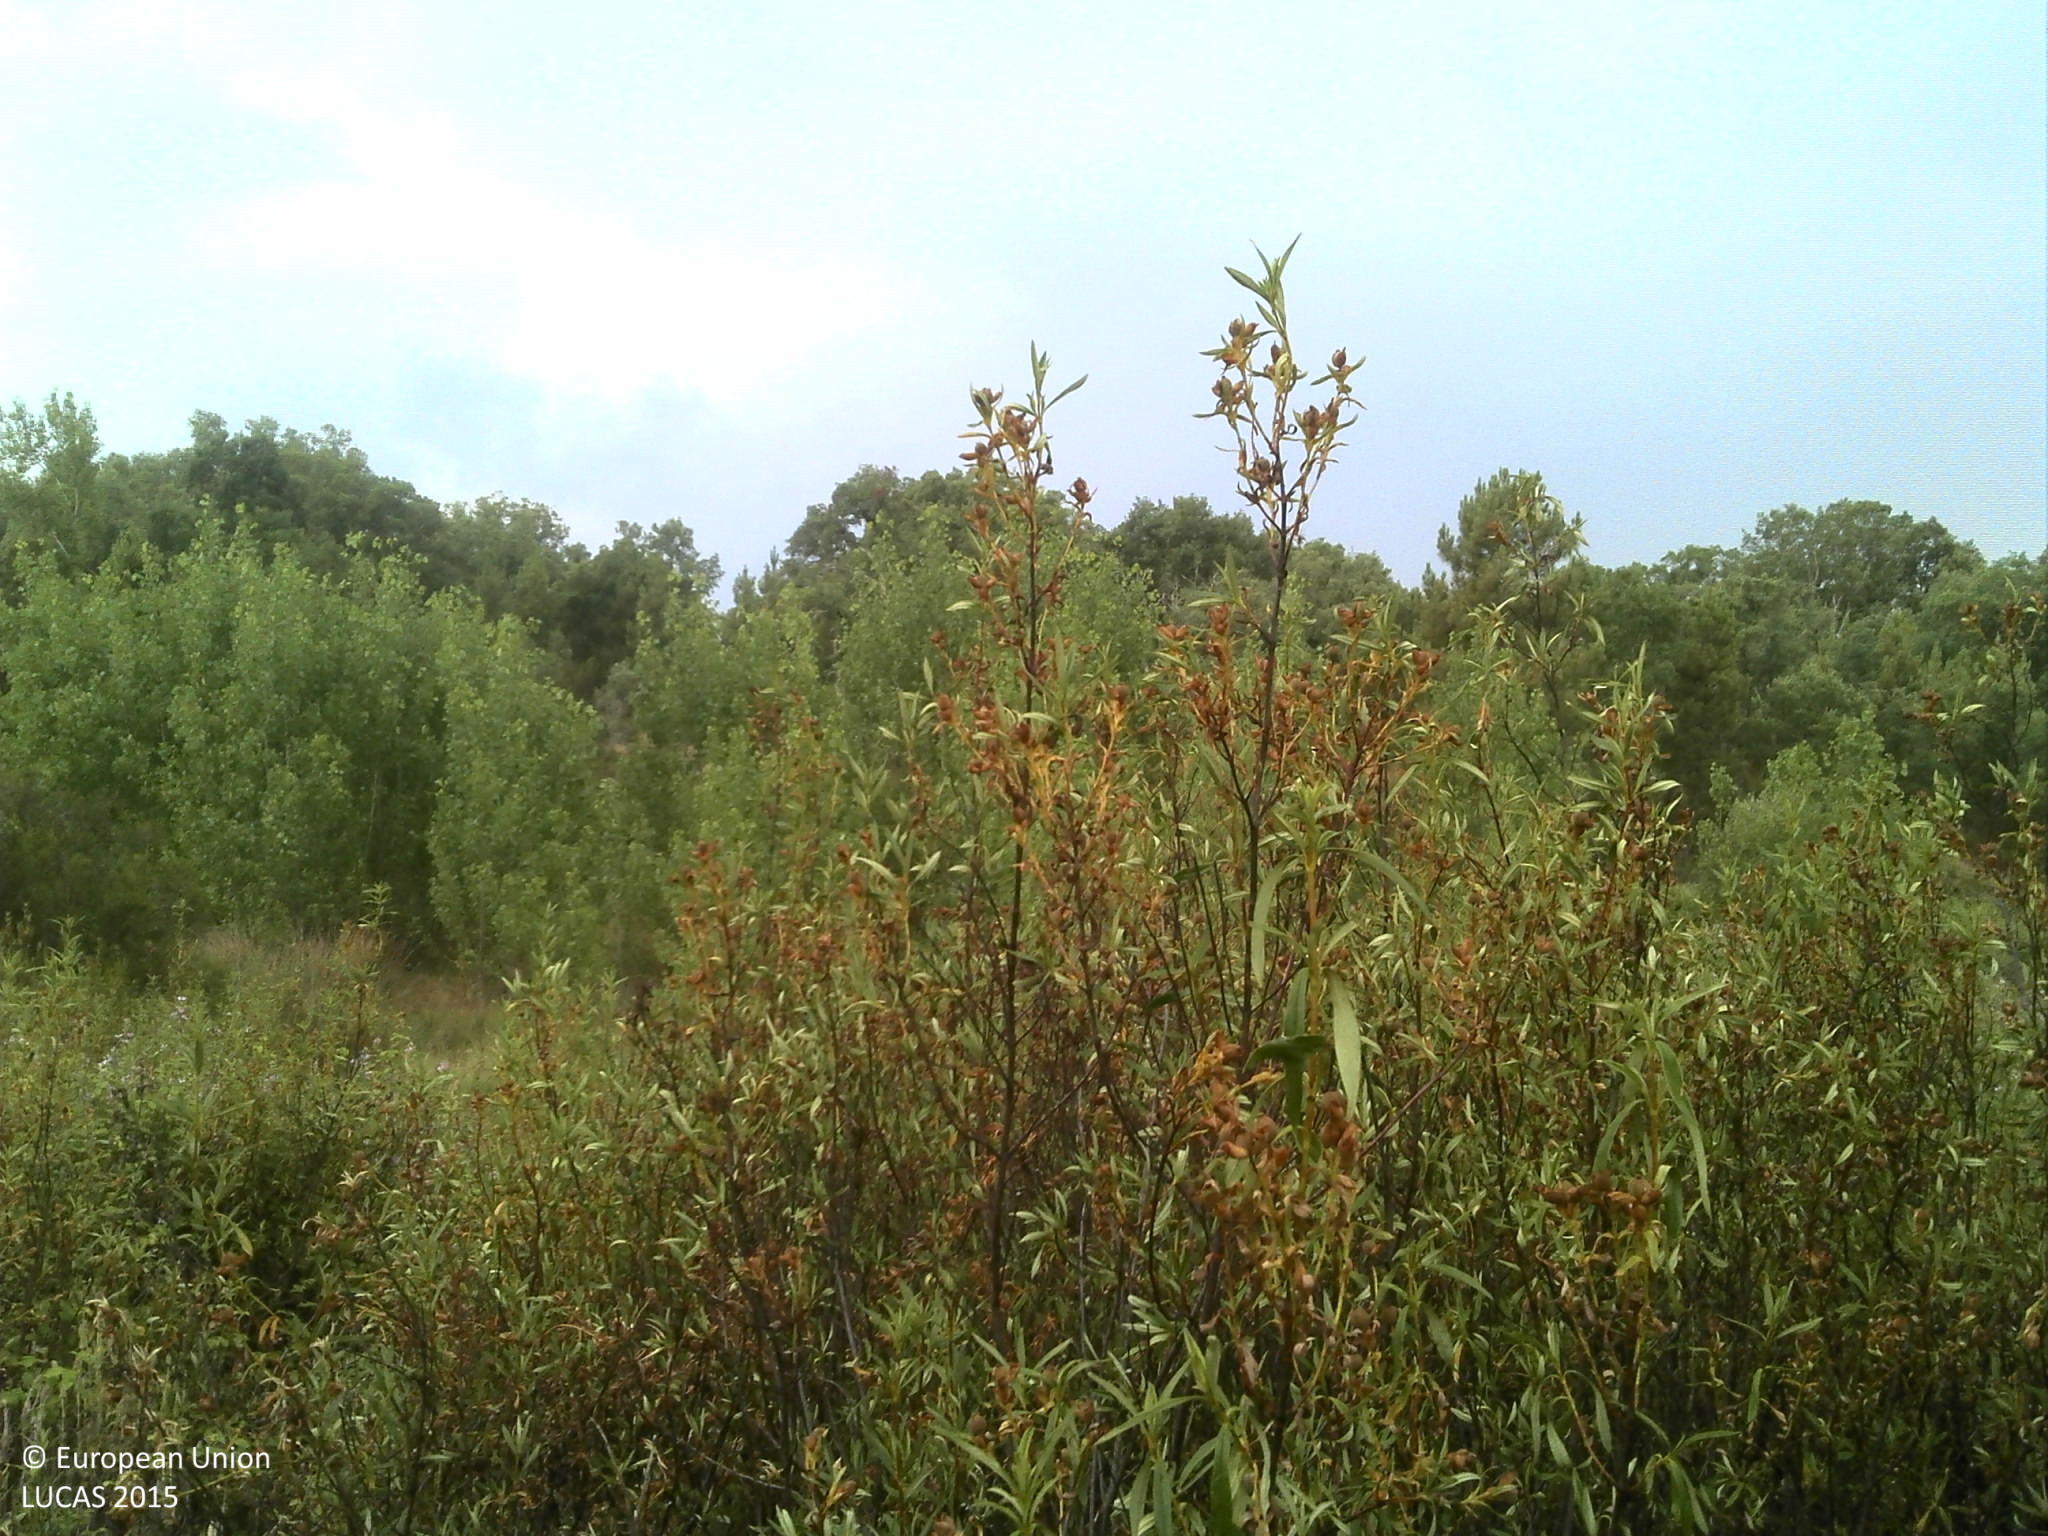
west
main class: Woodland
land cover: Broadleaved woodland
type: broadleaved evergreen forest
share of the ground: 10 - 25 %
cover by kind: shrubs 50 %, broadleaved forest trees 25 %, unconsolidated bare surface 15 %, herbaceous plants 10 %
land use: Forestry
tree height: > 5 m
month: June
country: PT
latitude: 39.3702
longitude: -8.0615
